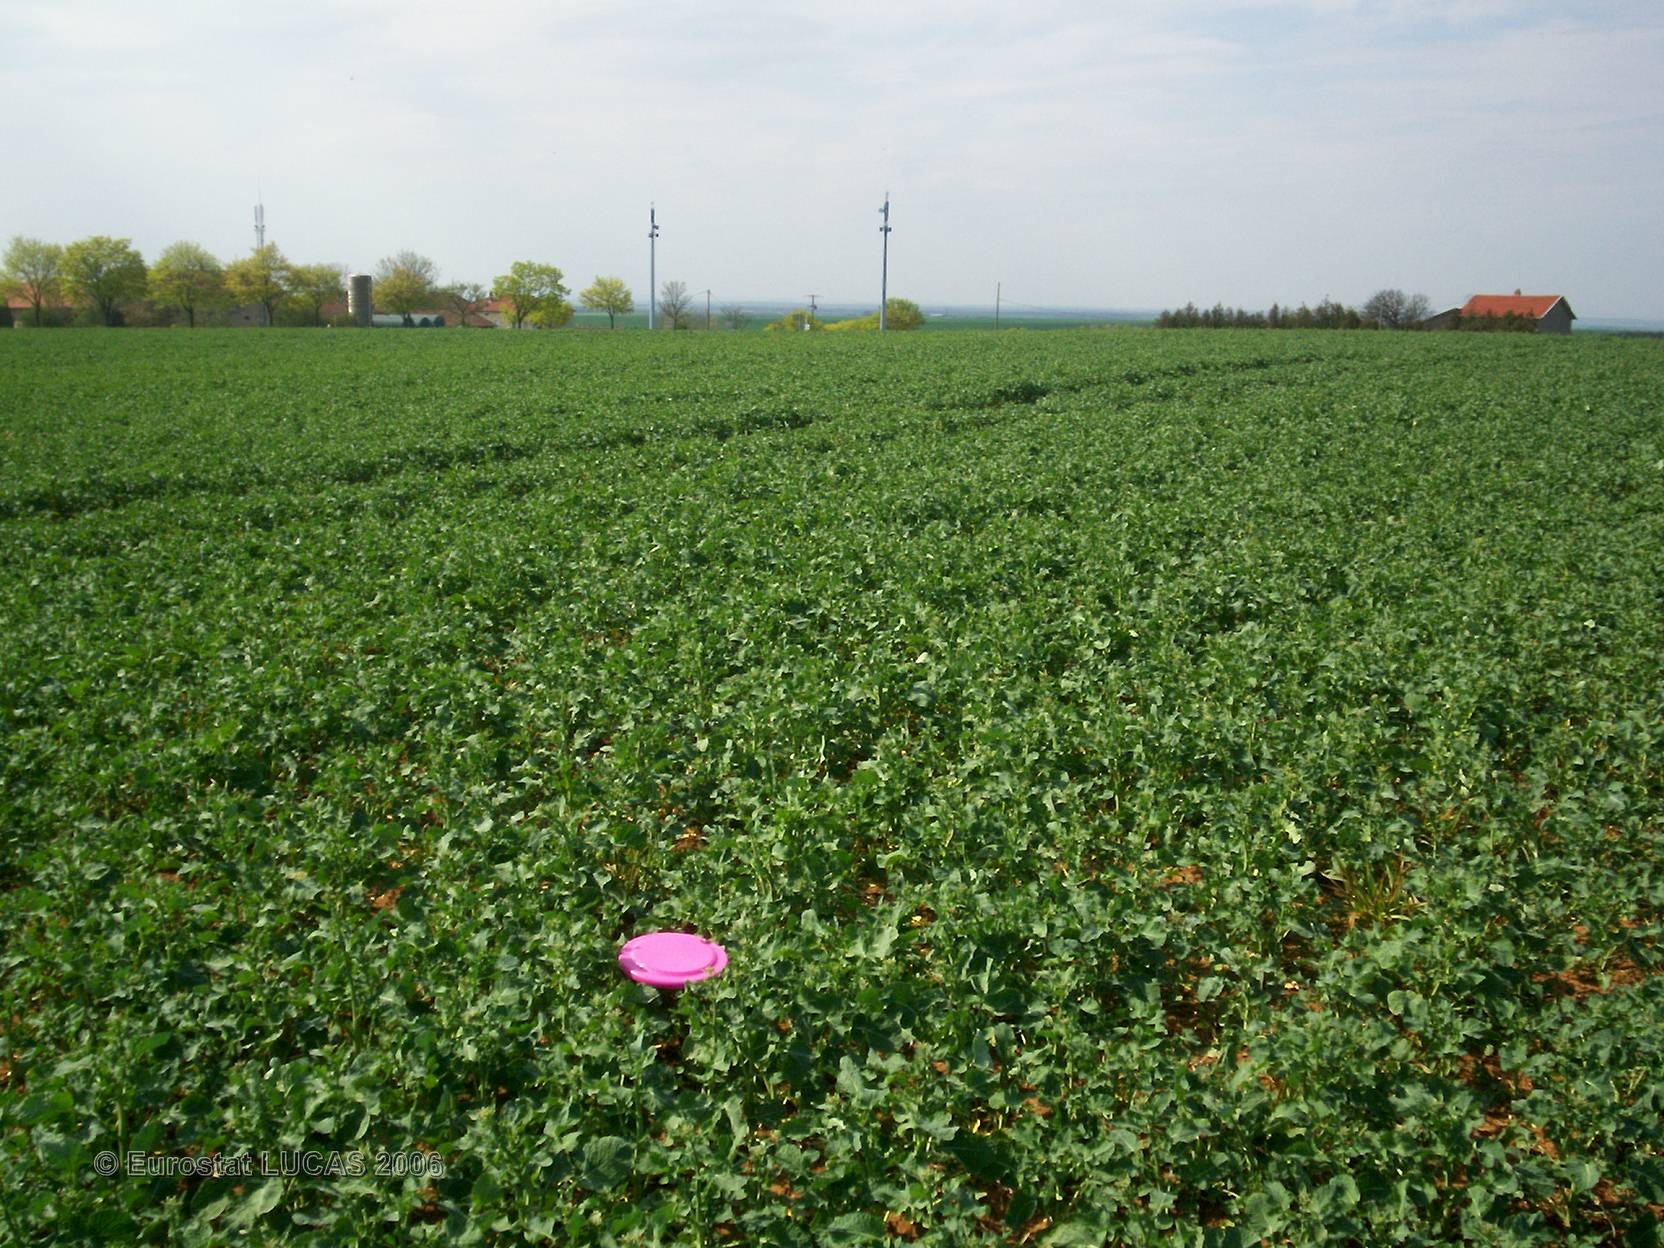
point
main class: Cropland
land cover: Rape and turnip rape
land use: Agriculture (excluding fallow land and kitchen gardens)
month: April
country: FR
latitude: 49.0494
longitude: 5.9358
